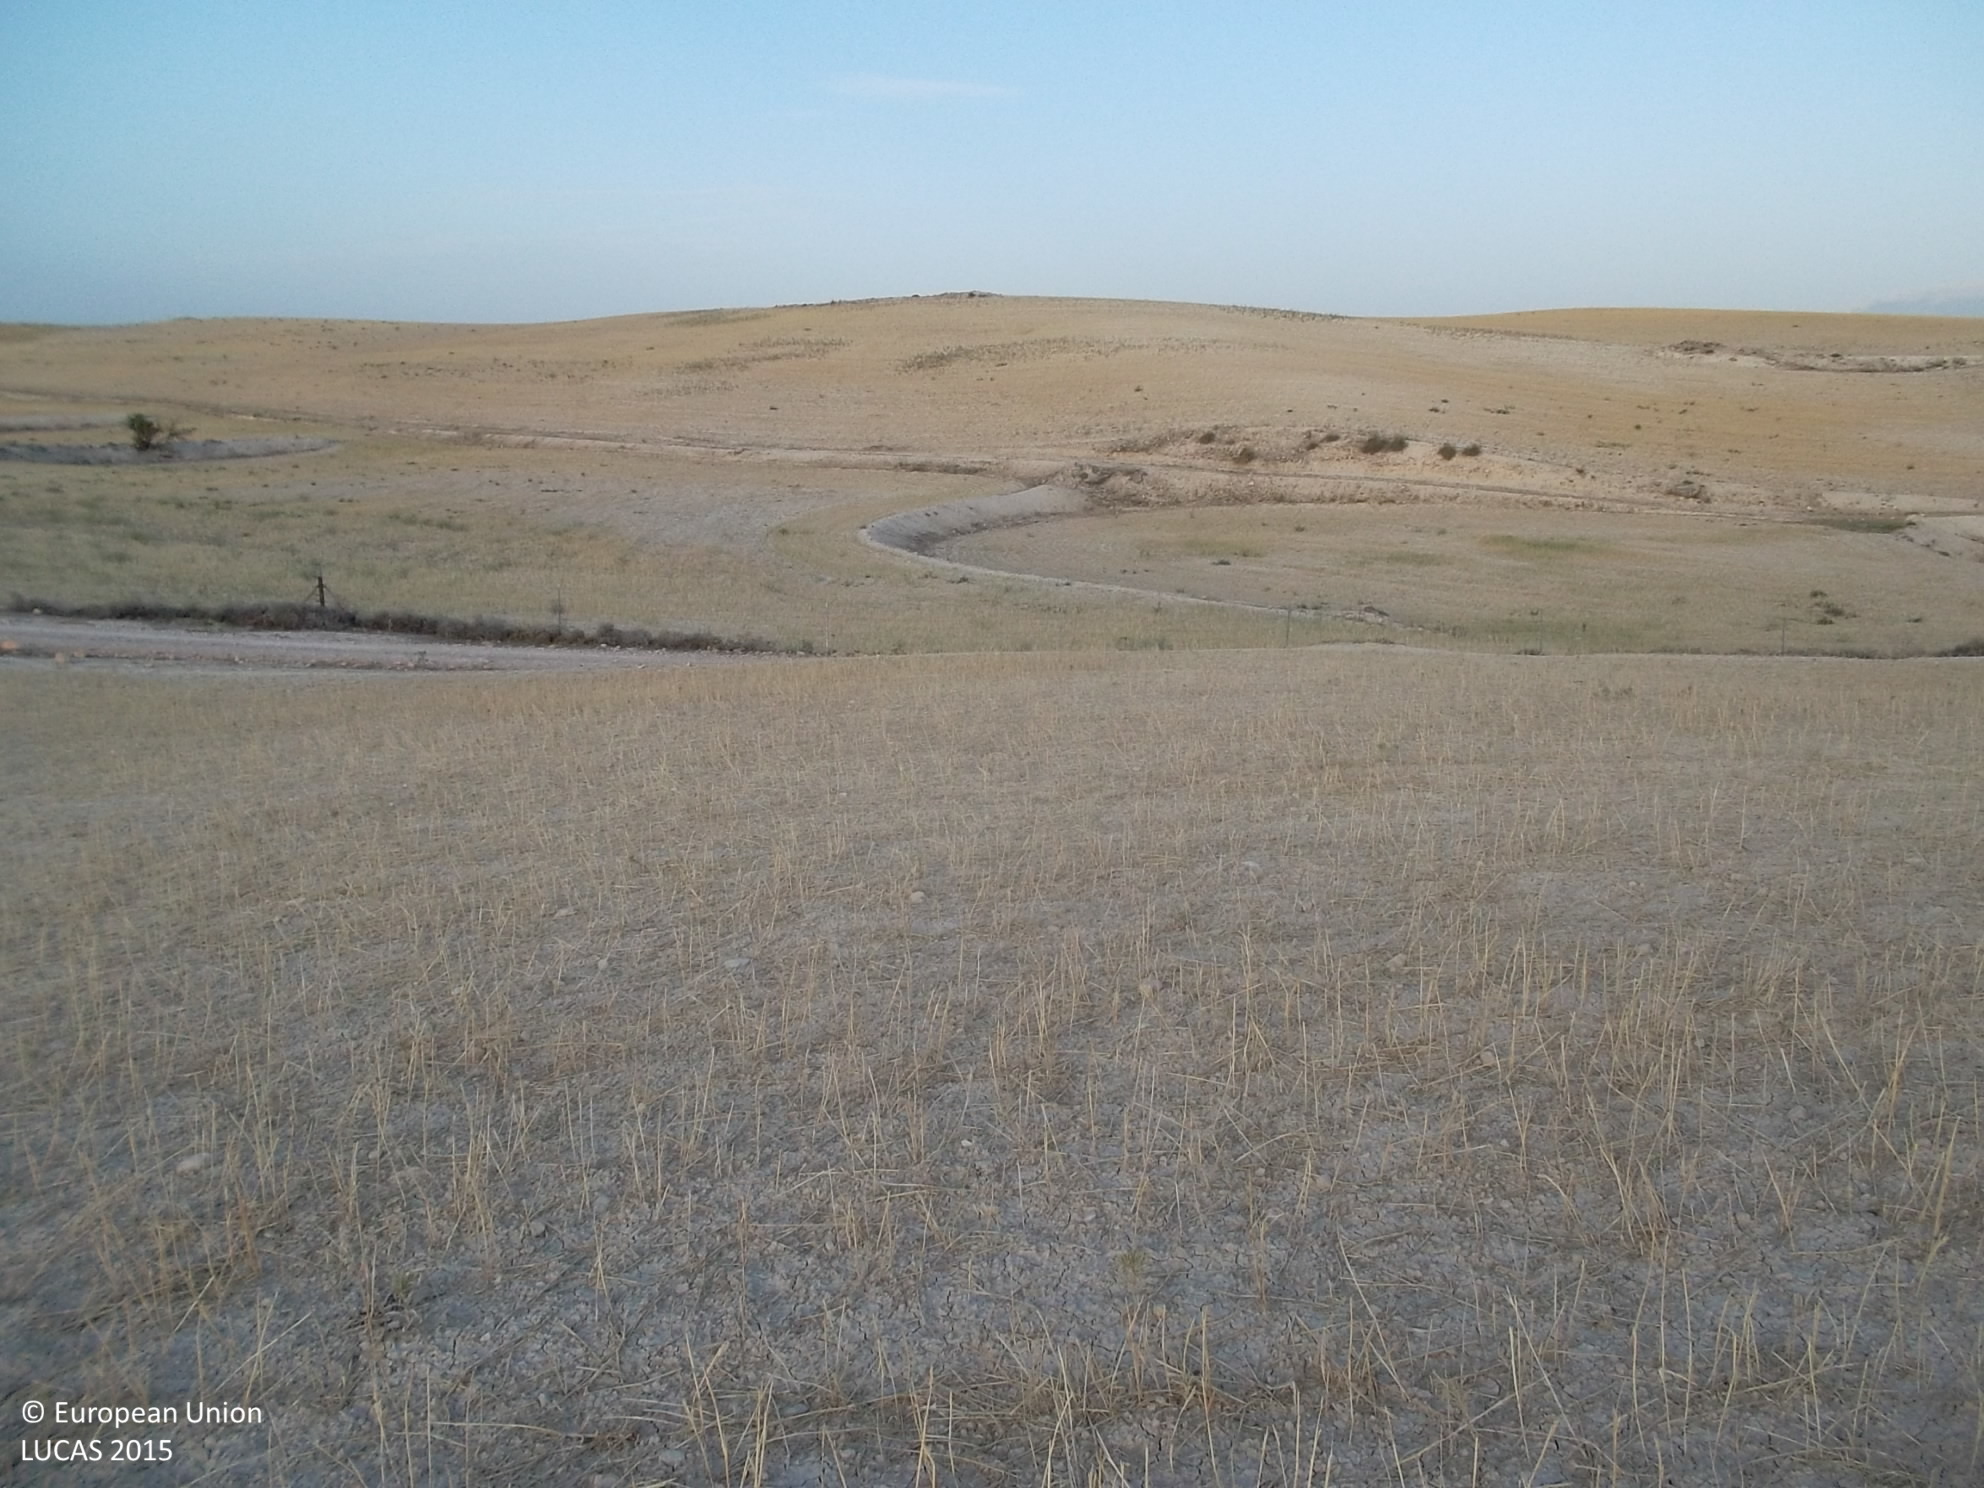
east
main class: Cropland
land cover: Barley
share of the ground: > 75 %
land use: Agriculture (excluding fallow land and kitchen gardens)
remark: Harvested field
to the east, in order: Barley; Grass margins; Tracks; Grass margins; Fences; Barley; Grass margins; Tracks; Grass margins; Barley
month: July
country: ES
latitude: 37.7878
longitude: -2.4456
